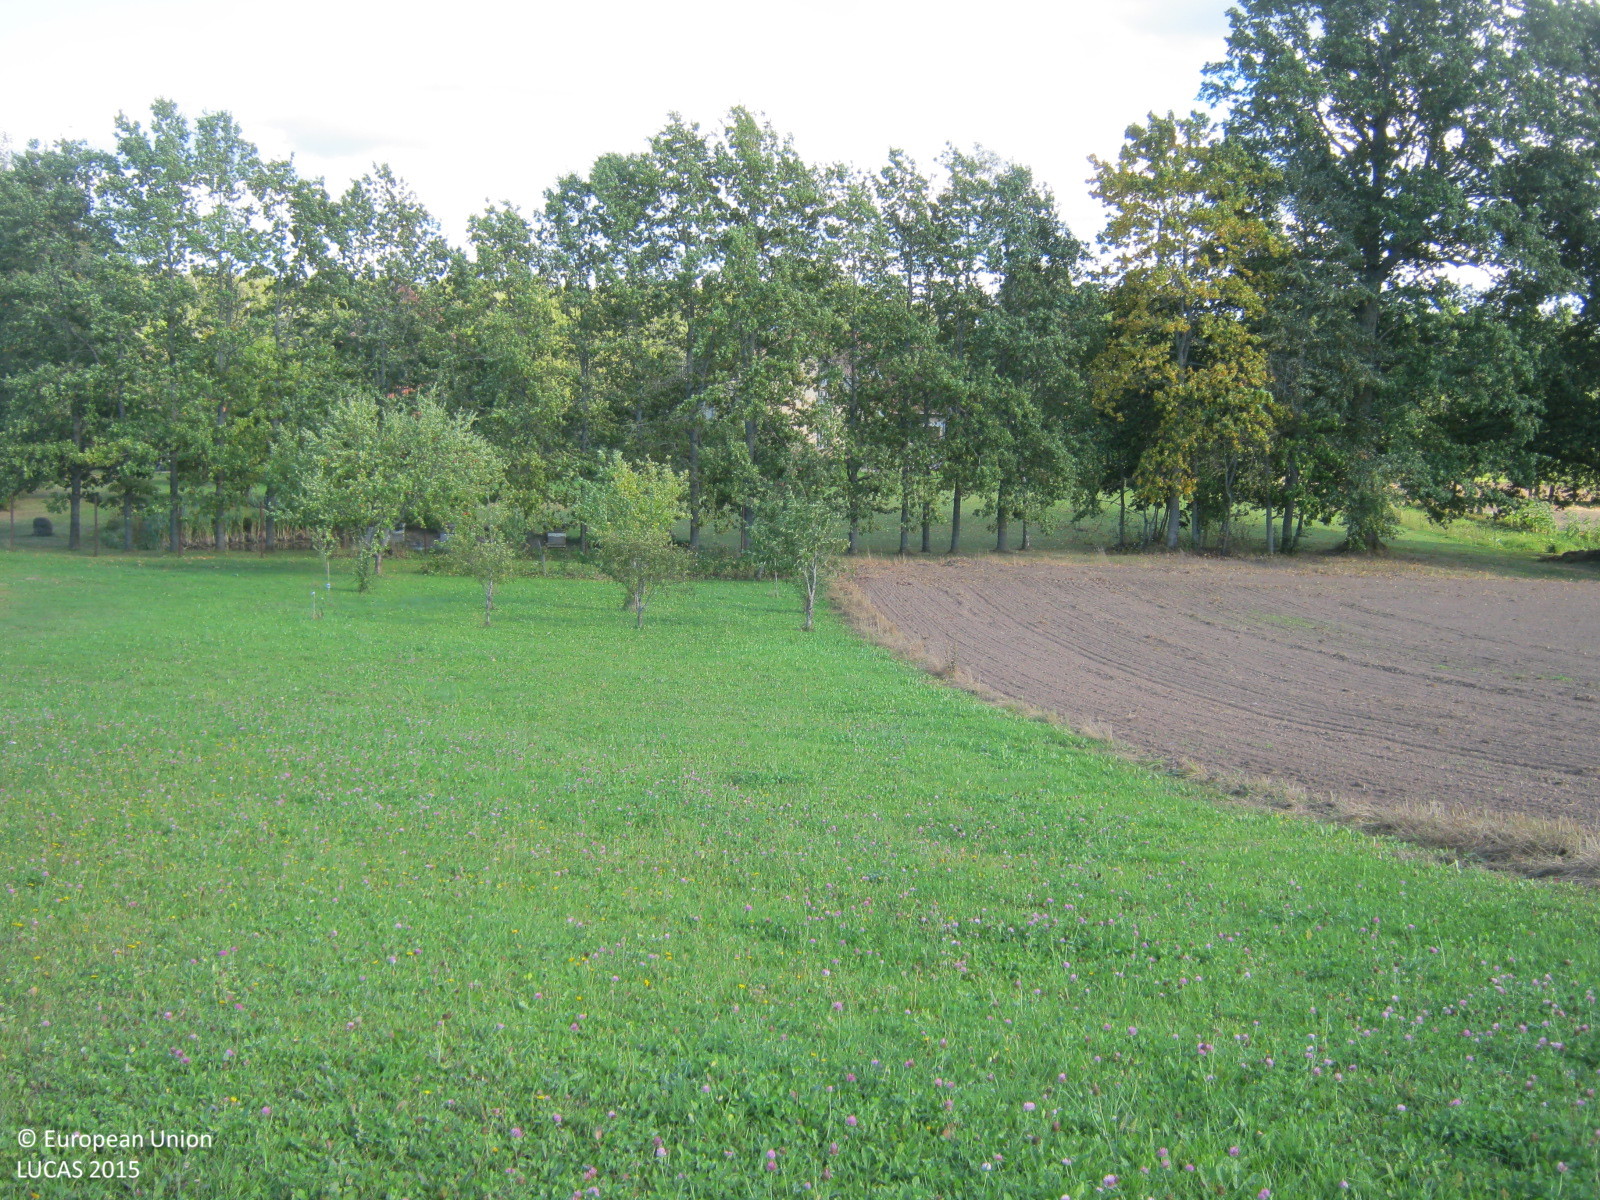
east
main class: Grassland
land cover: Grassland without tree/shrub cover
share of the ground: > 75 %
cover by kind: herbaceous plants 100 %
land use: Agriculture (excluding fallow land and kitchen gardens)
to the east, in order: Grassland without tree/shrub cover; Other fruit trees and berries; Broadleaved woodland; Inland fresh water bodies; Grassland without tree/shrub cover; Artificial constructions in urban areas; Grassland without tree/shrub cover
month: September
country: LV
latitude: 57.2689
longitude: 24.6043
